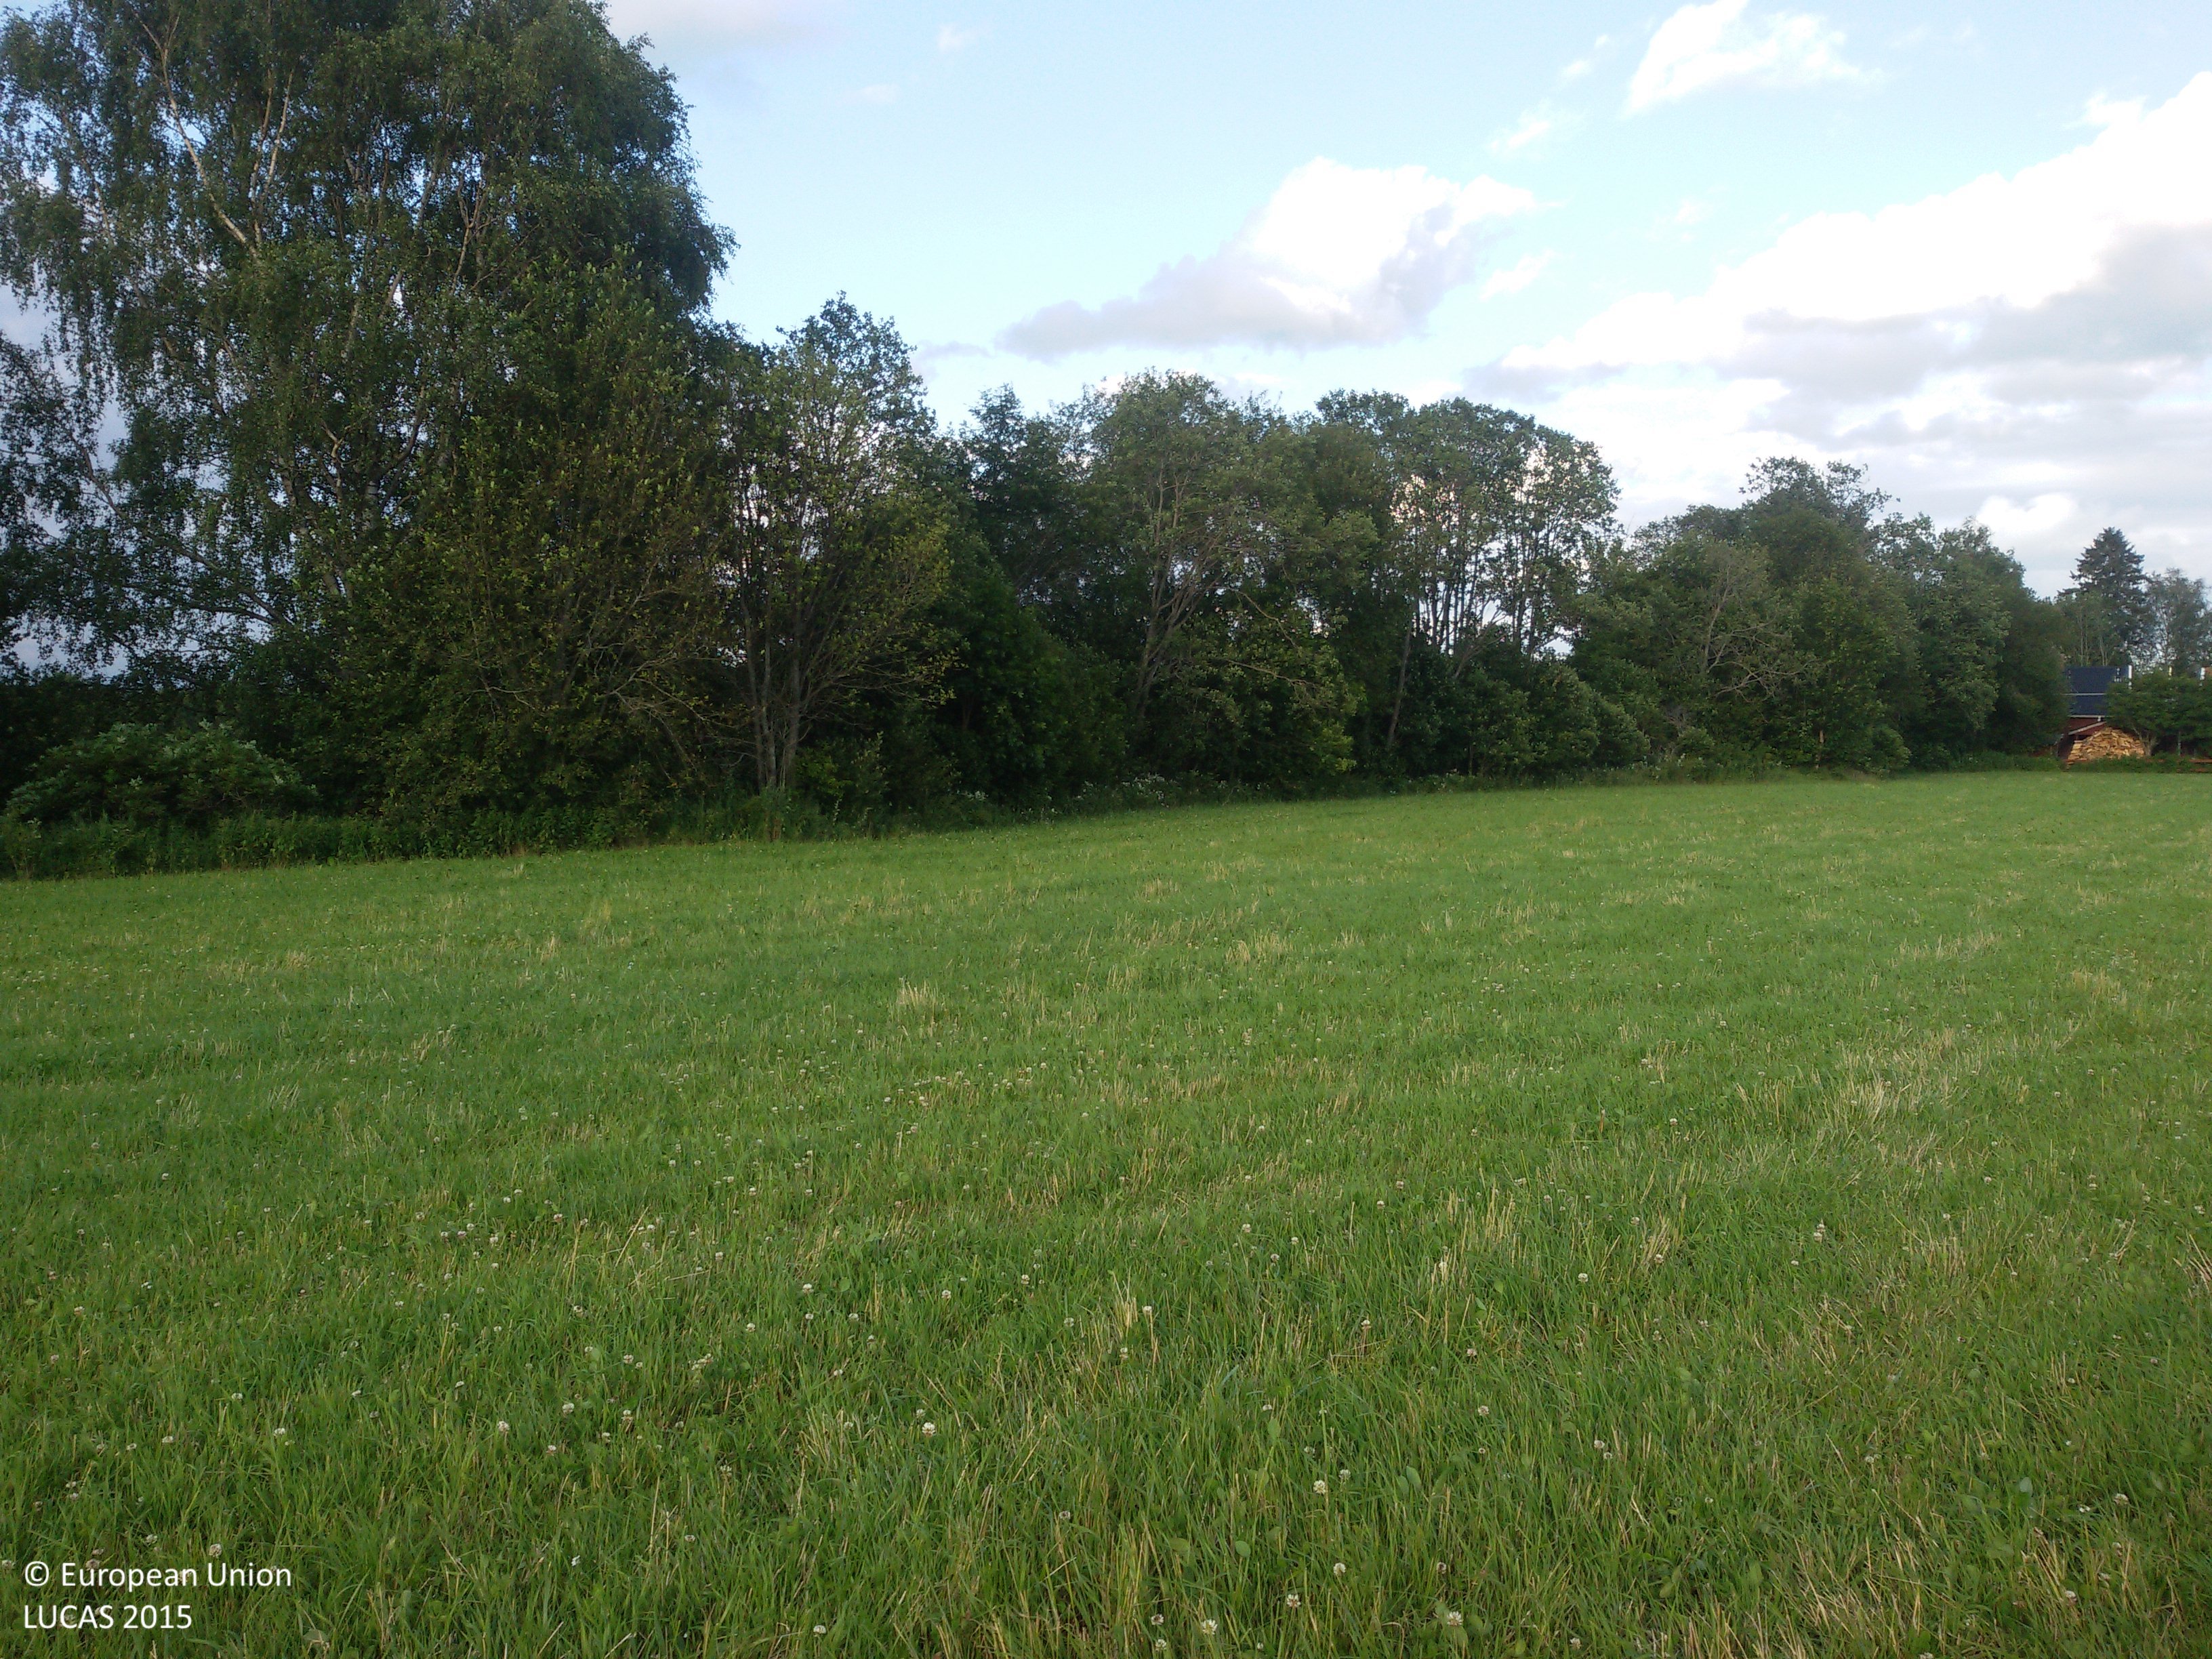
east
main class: Grassland
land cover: Grassland without tree/shrub cover
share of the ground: > 75 %
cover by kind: herbaceous plants 100 %
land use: Agriculture (excluding fallow land and kitchen gardens)
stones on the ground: < 10 %
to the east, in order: Grassland without tree/shrub cover; Broadleaved woodland; Inland fresh running water
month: July
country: SE
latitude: 60.5120
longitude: 15.3603
